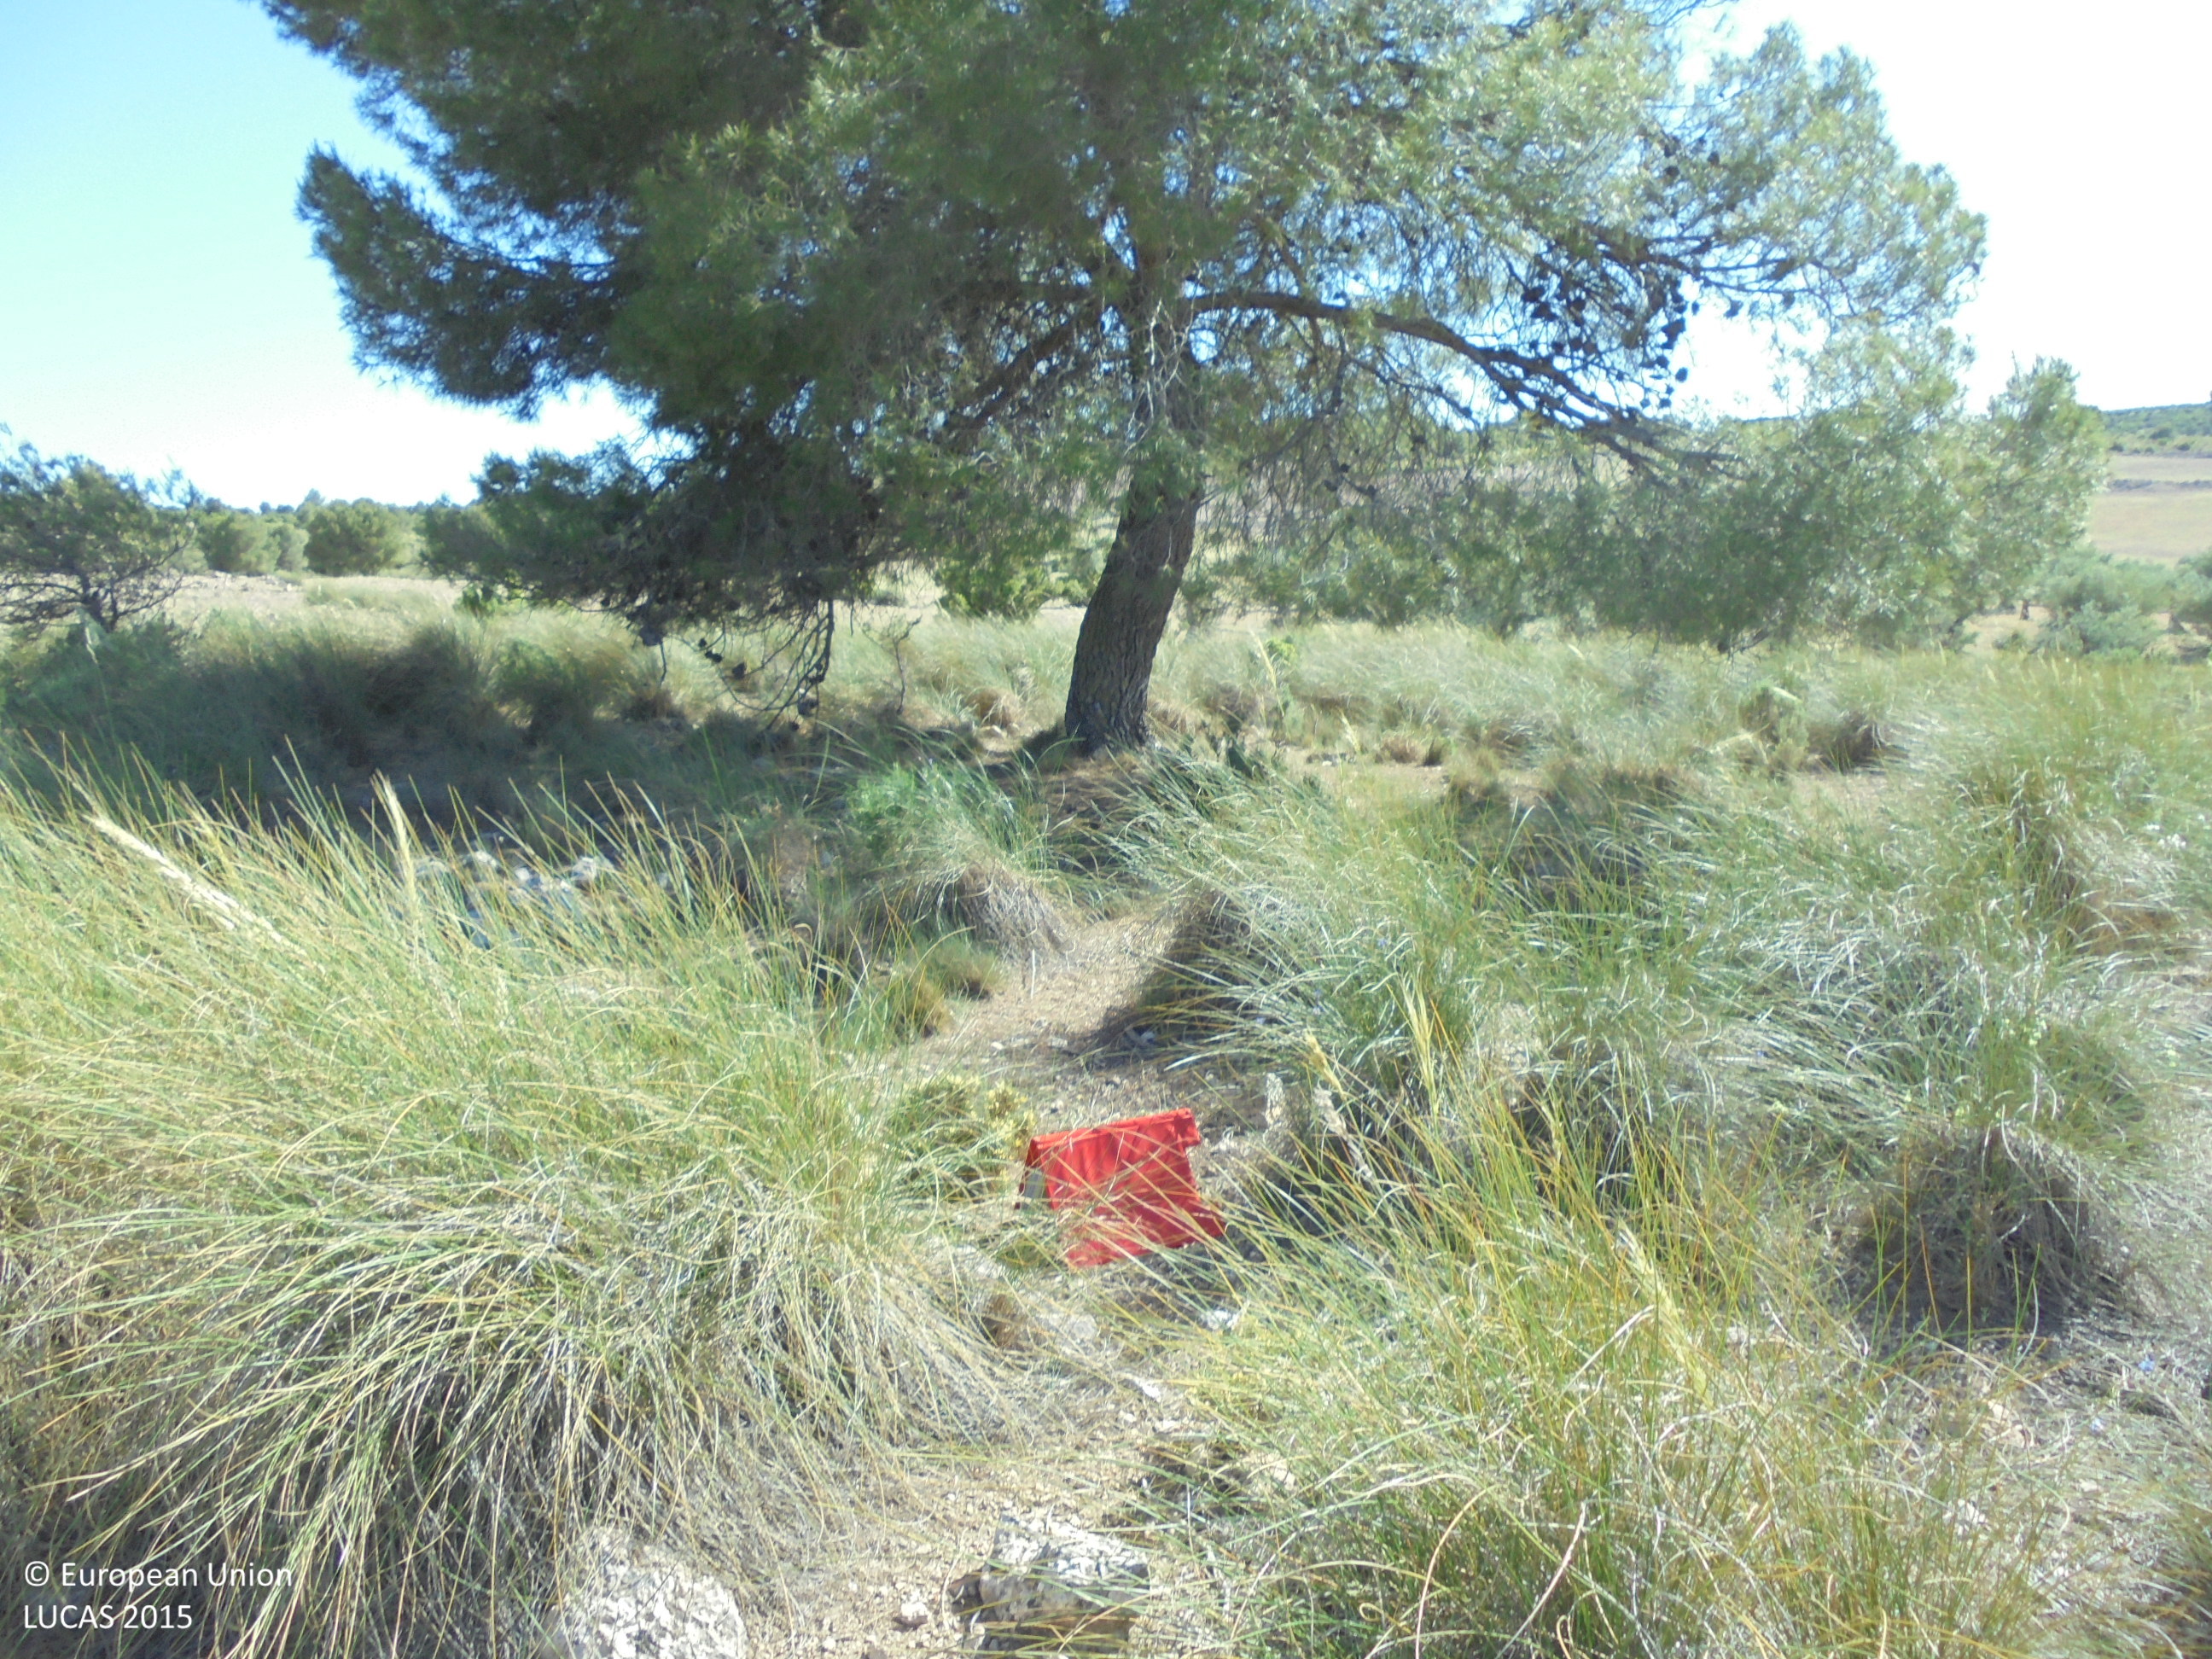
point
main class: Shrubland
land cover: Shrubland with sparse tree cover
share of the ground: > 75 %
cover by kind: shrubs 80 %, unconsolidated bare surface 15 %, coniferous forest trees 5 %
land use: Semi-natural and natural areas not in use
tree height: > 5 m
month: May
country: ES
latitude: 39.0566
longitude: -1.5201
